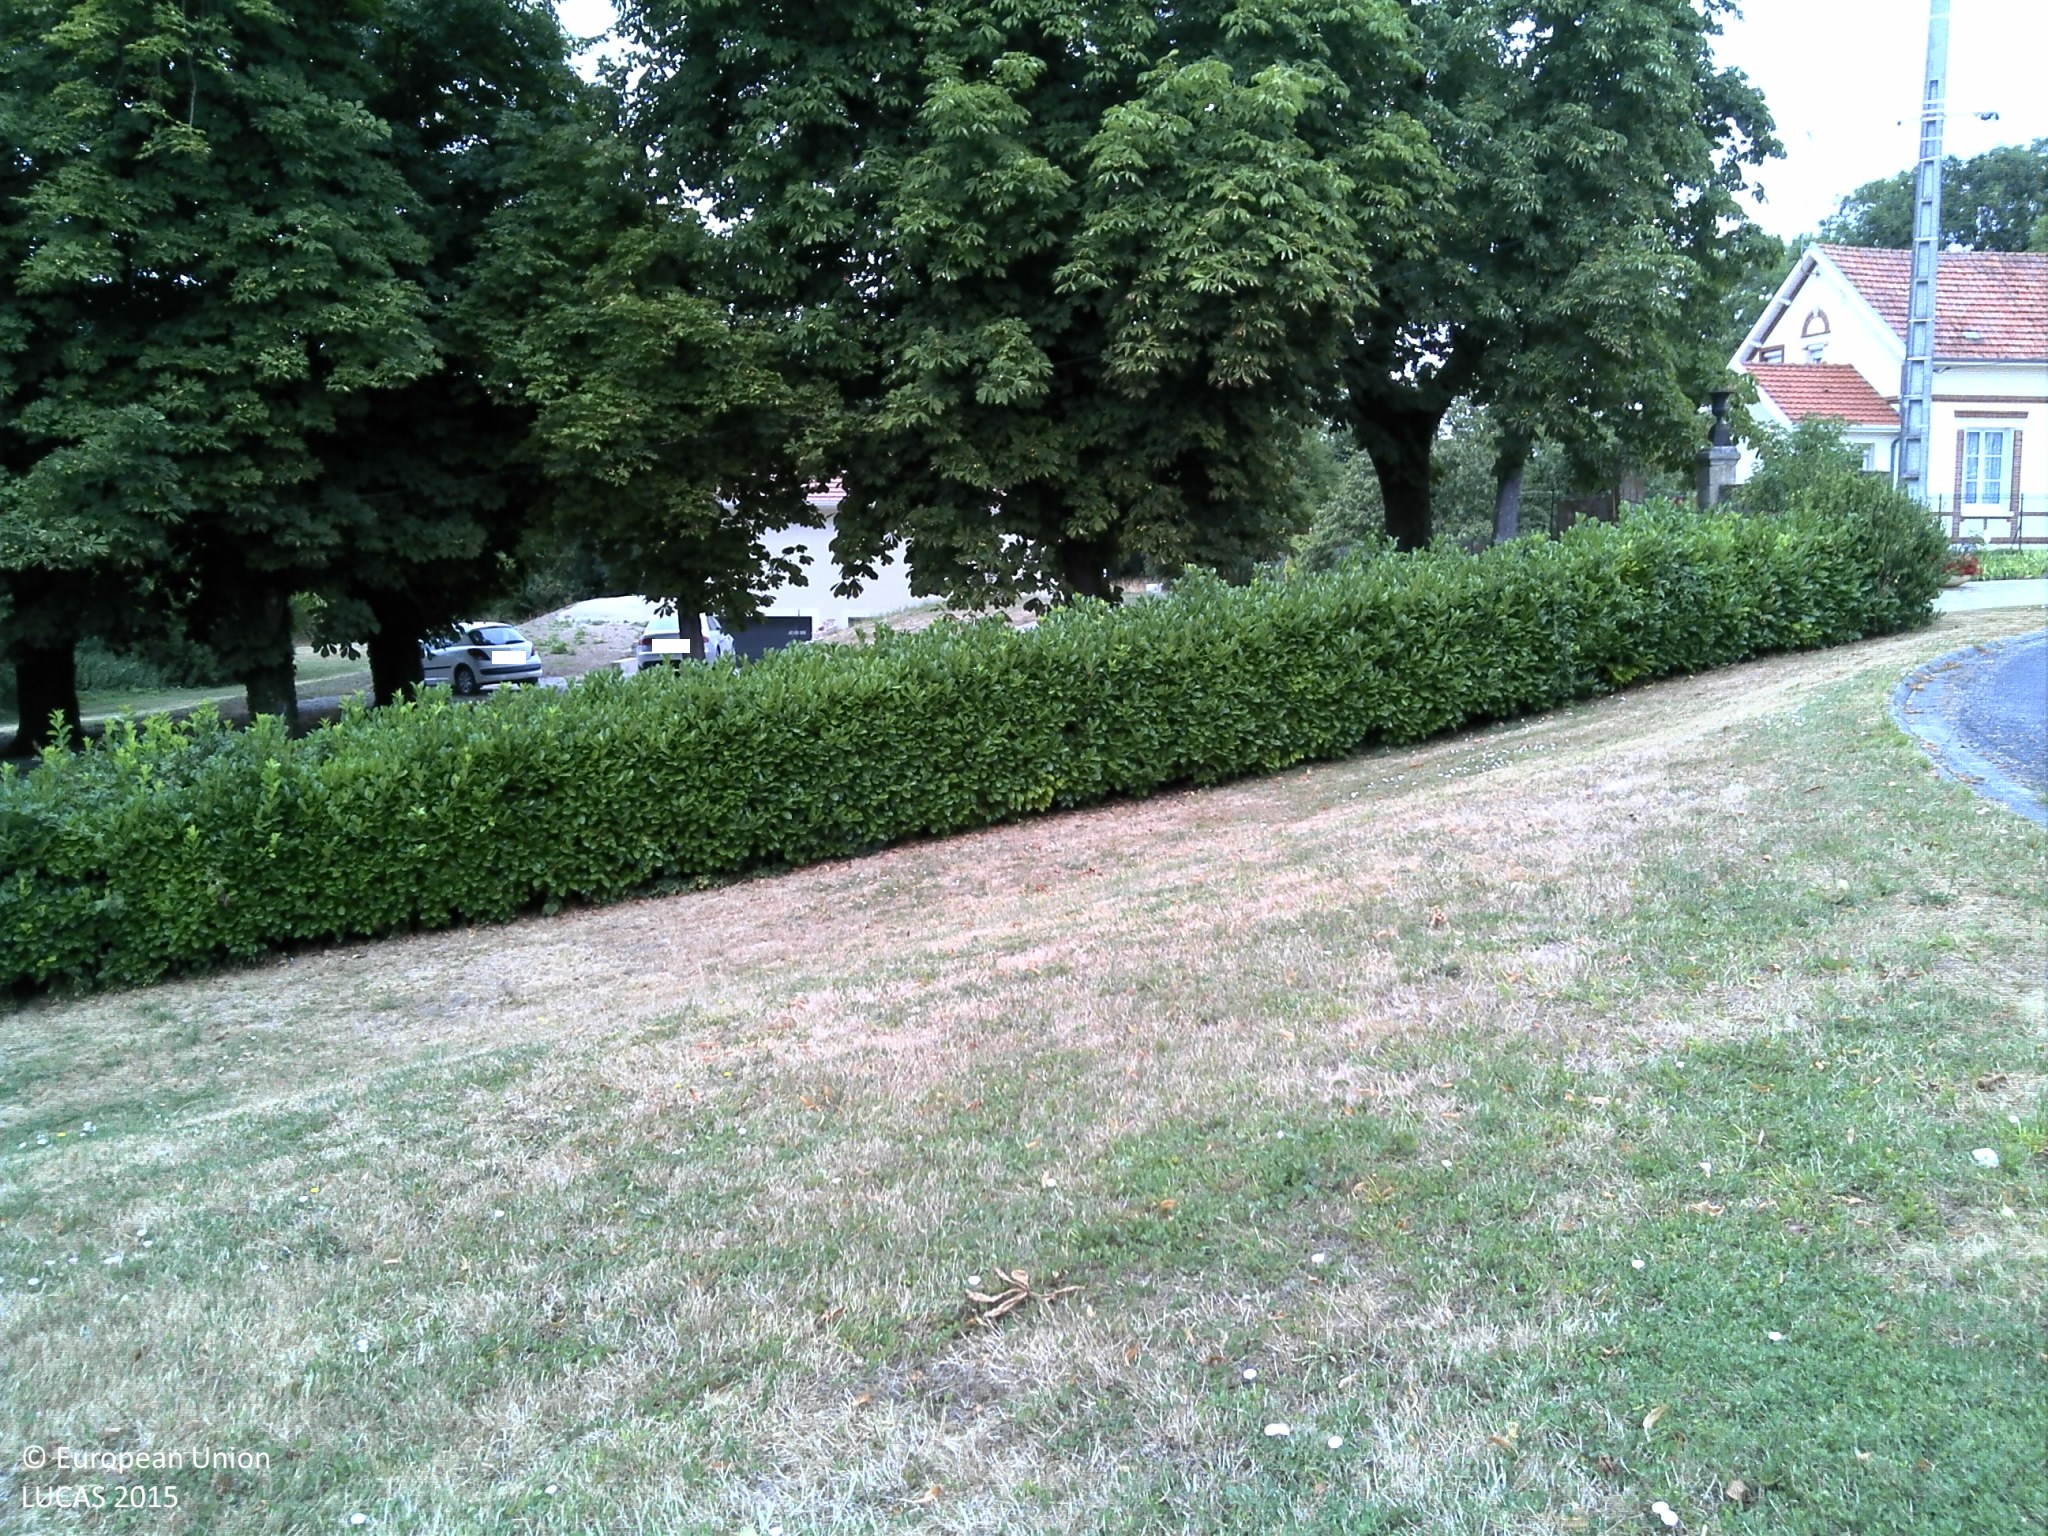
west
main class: Grassland
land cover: Grassland without tree/shrub cover
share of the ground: > 75 %
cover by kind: herbaceous plants 95 %, shrubs 5 %
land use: Residential
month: July
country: FR
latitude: 48.6904
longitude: 4.6858
